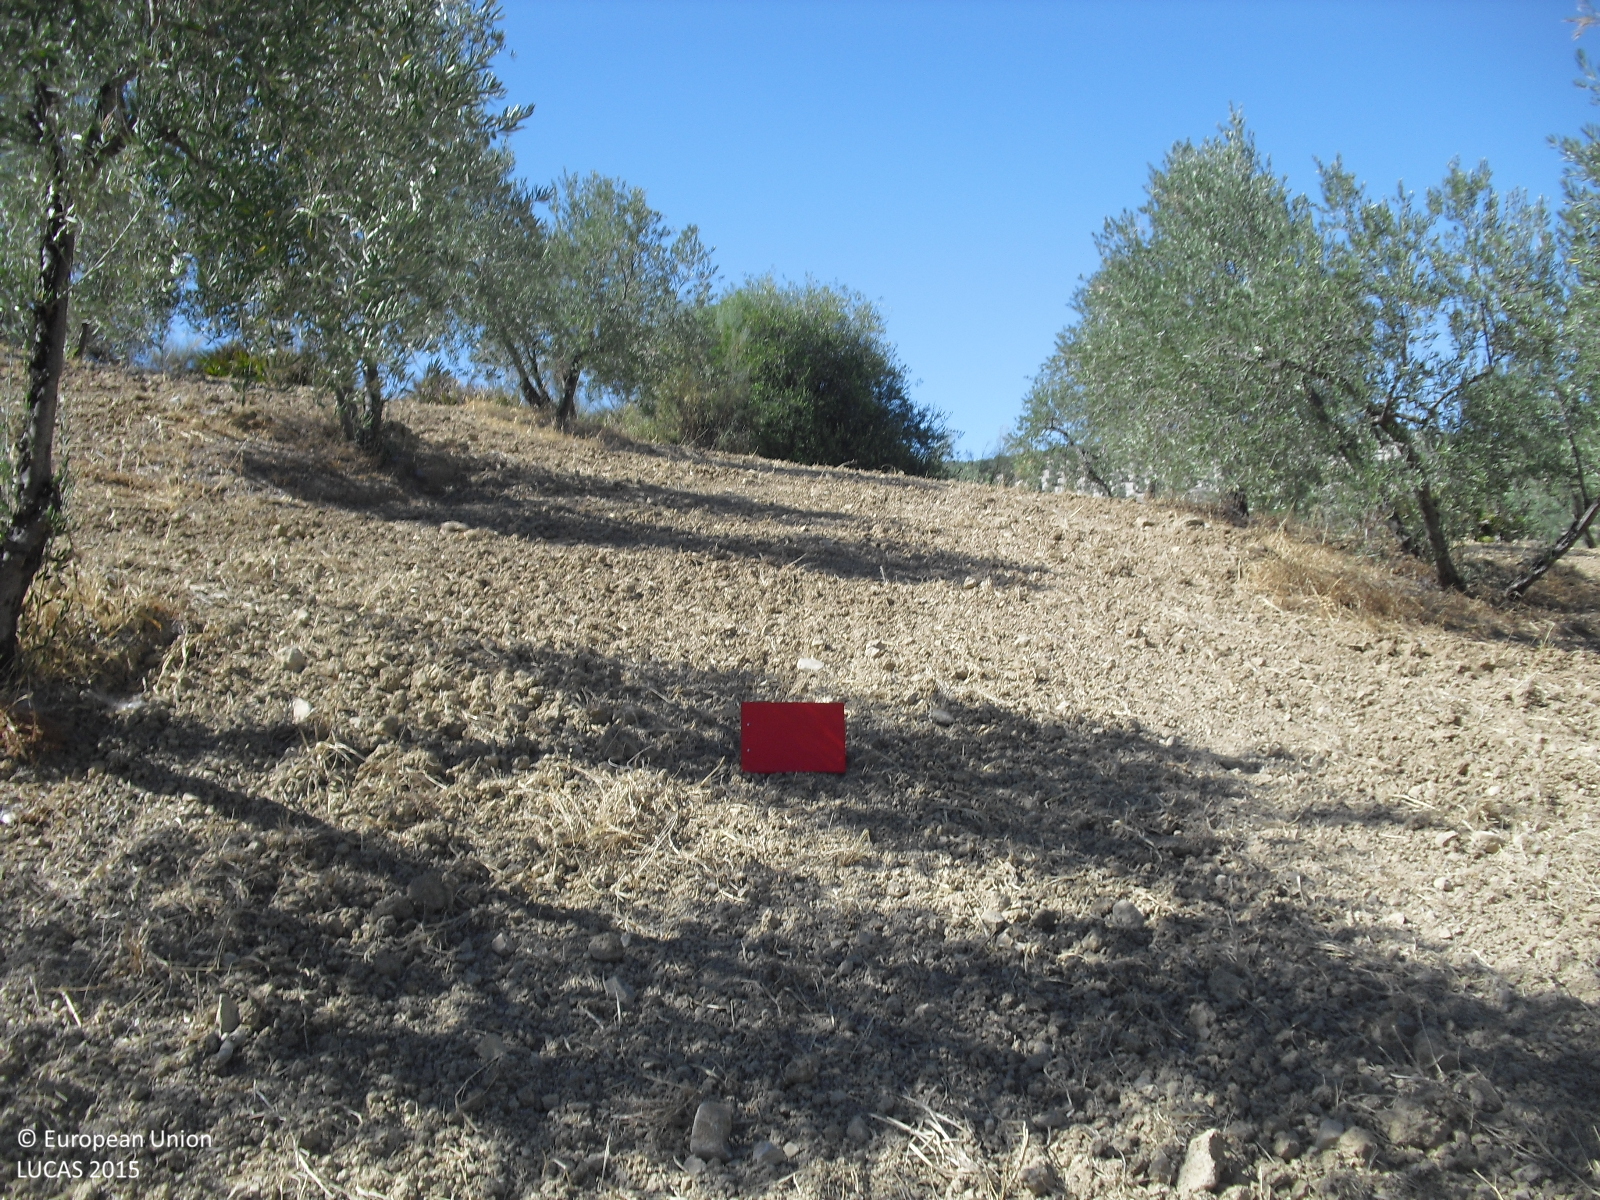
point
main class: Cropland
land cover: Olive groves
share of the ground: 25 - 50 %
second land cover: Other bare soil
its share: > 75 %
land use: Agriculture (excluding fallow land and kitchen gardens)
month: July
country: ES
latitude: 37.0091
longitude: -5.4610
